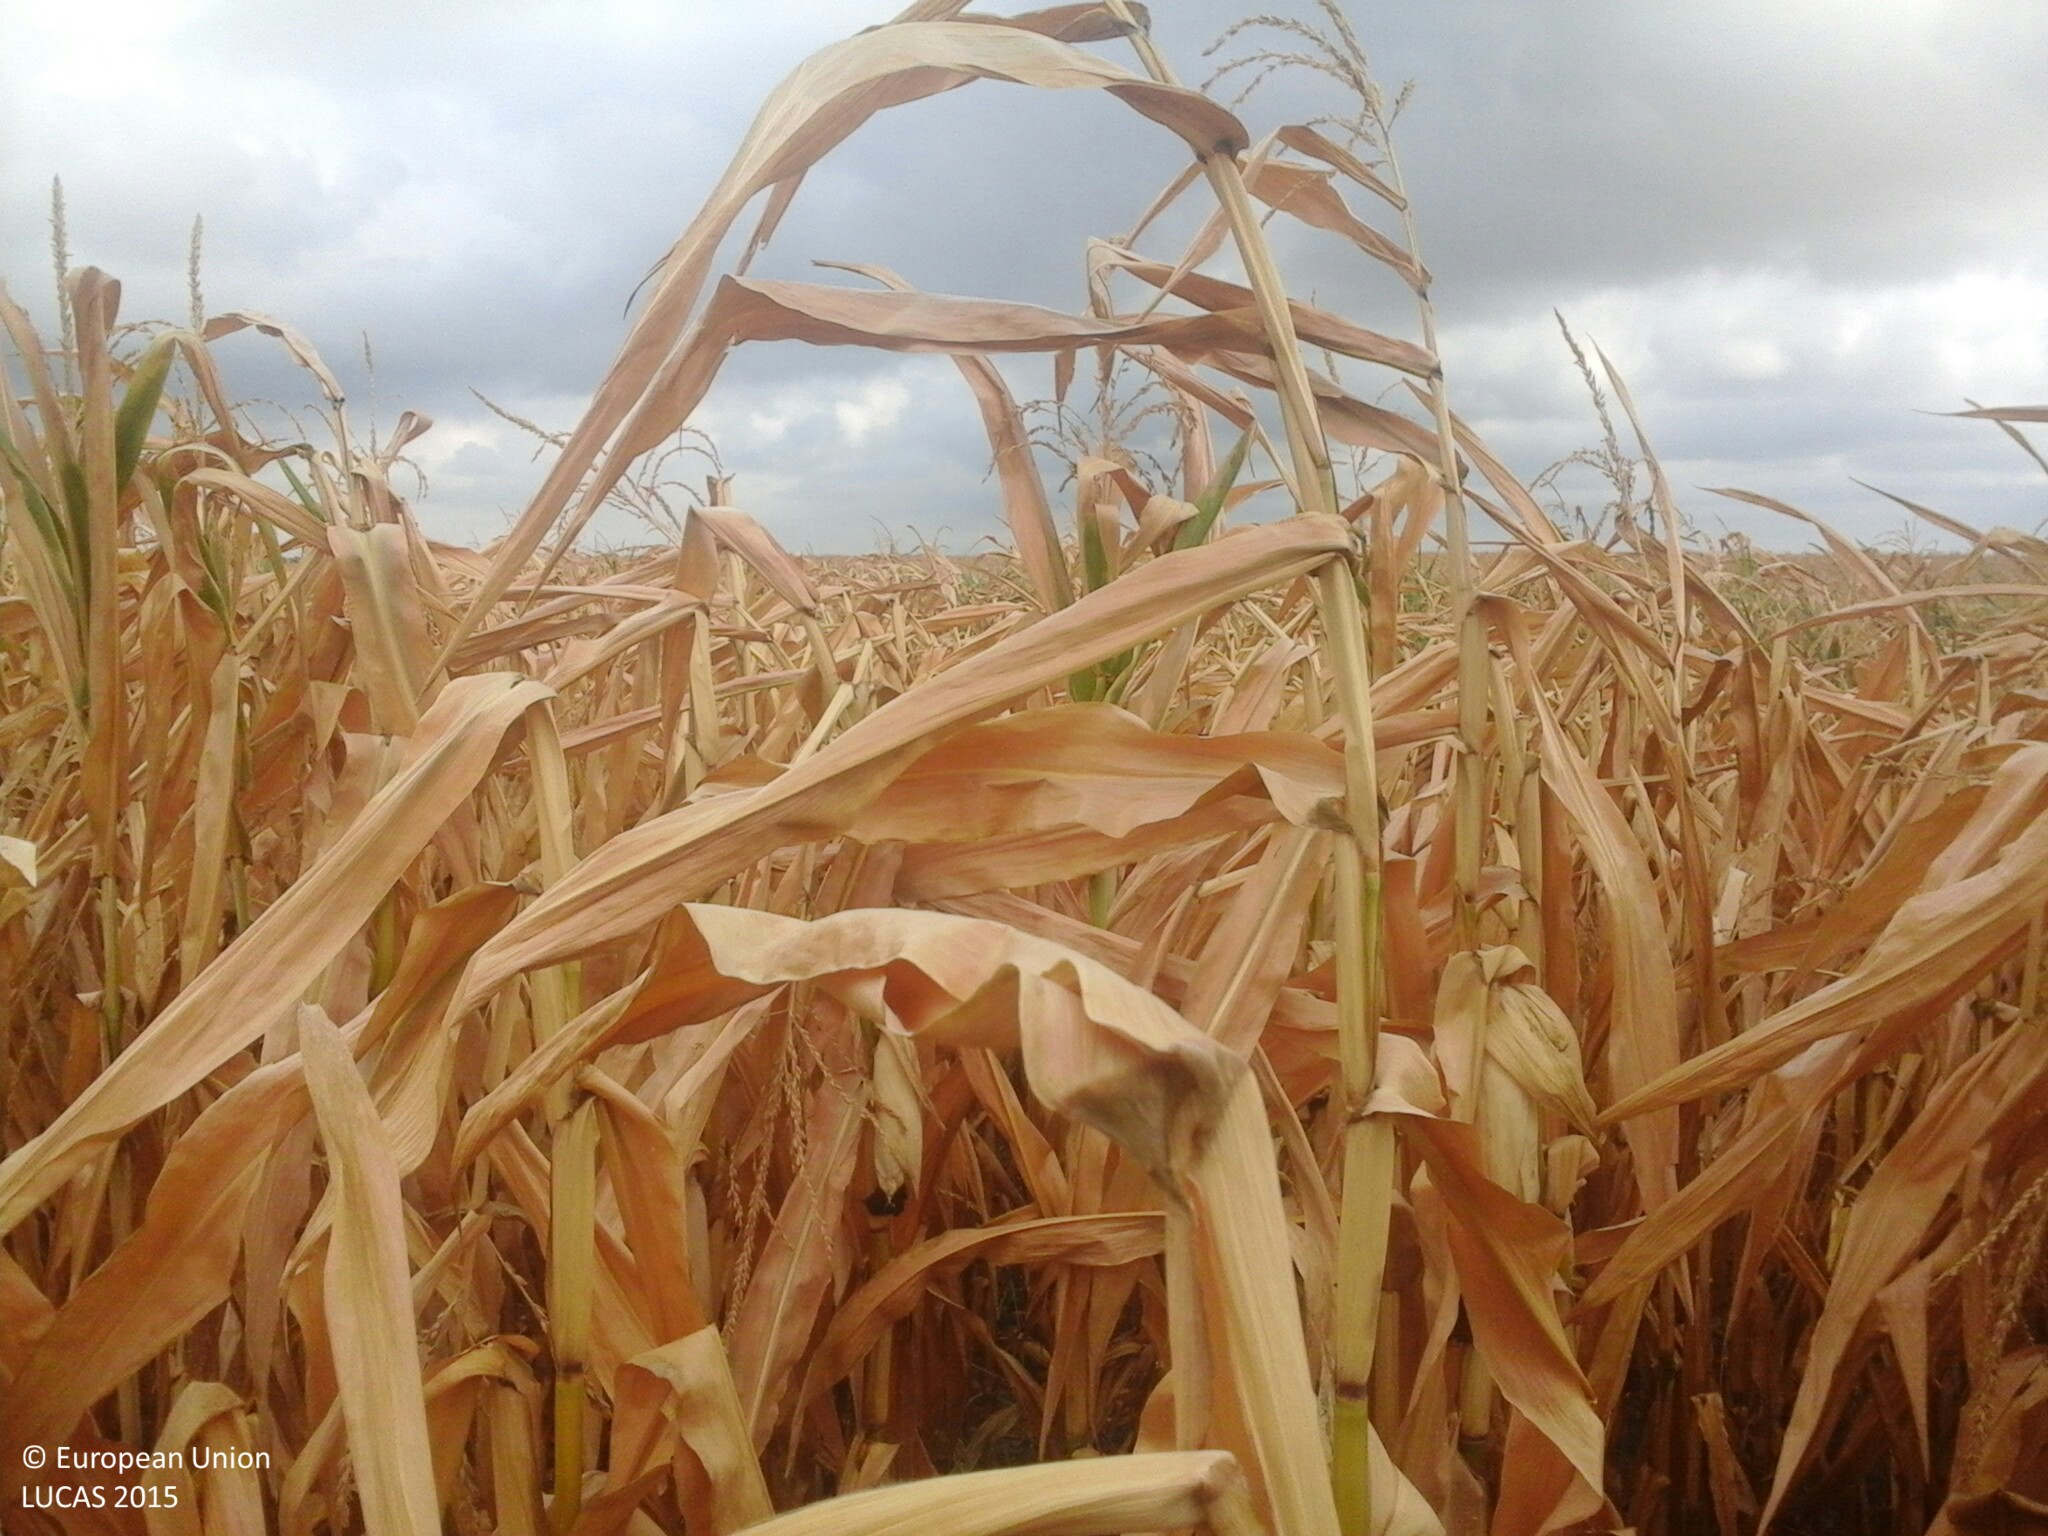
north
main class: Cropland
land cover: Maize
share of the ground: > 75 %
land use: Agriculture (excluding fallow land and kitchen gardens)
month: August
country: HU
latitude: 47.0497
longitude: 21.5593
